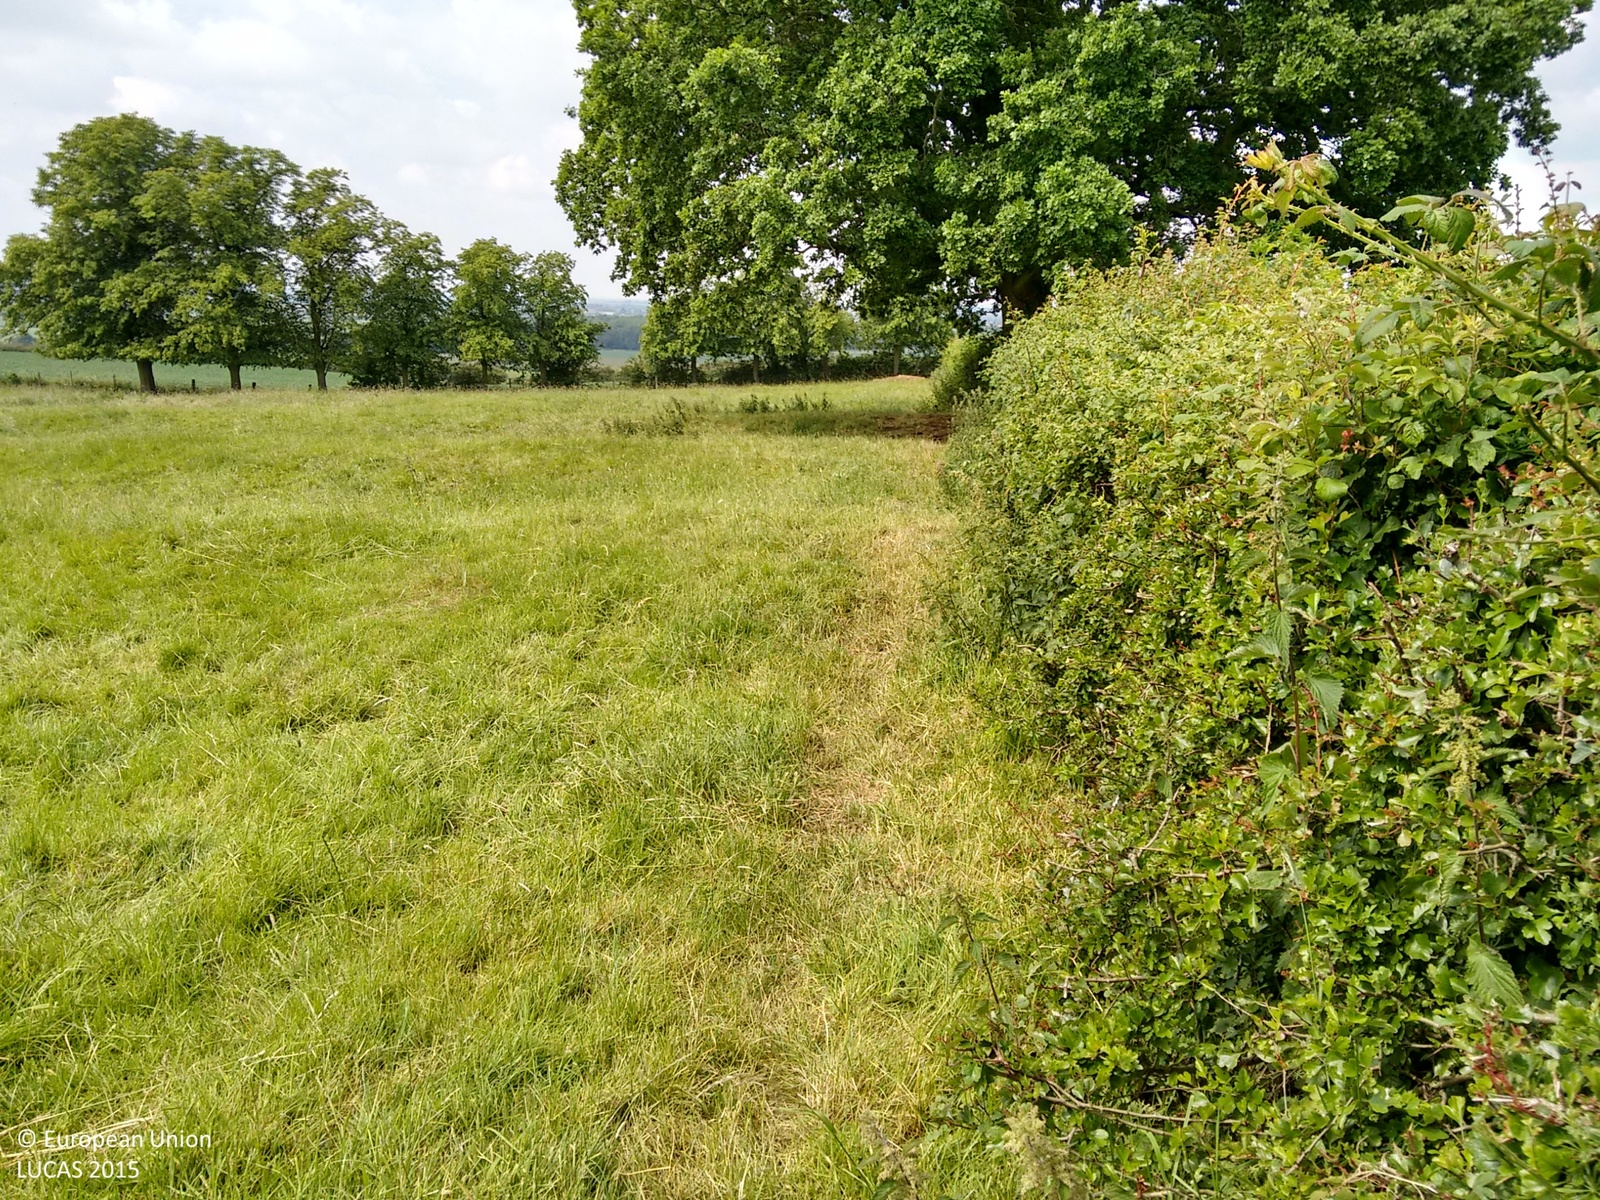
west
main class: Grassland
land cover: Grassland without tree/shrub cover
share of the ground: > 75 %
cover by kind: herbaceous plants 100 %
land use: Agriculture (excluding fallow land and kitchen gardens)
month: June
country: GB
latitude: 53.0252
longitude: -0.6097
